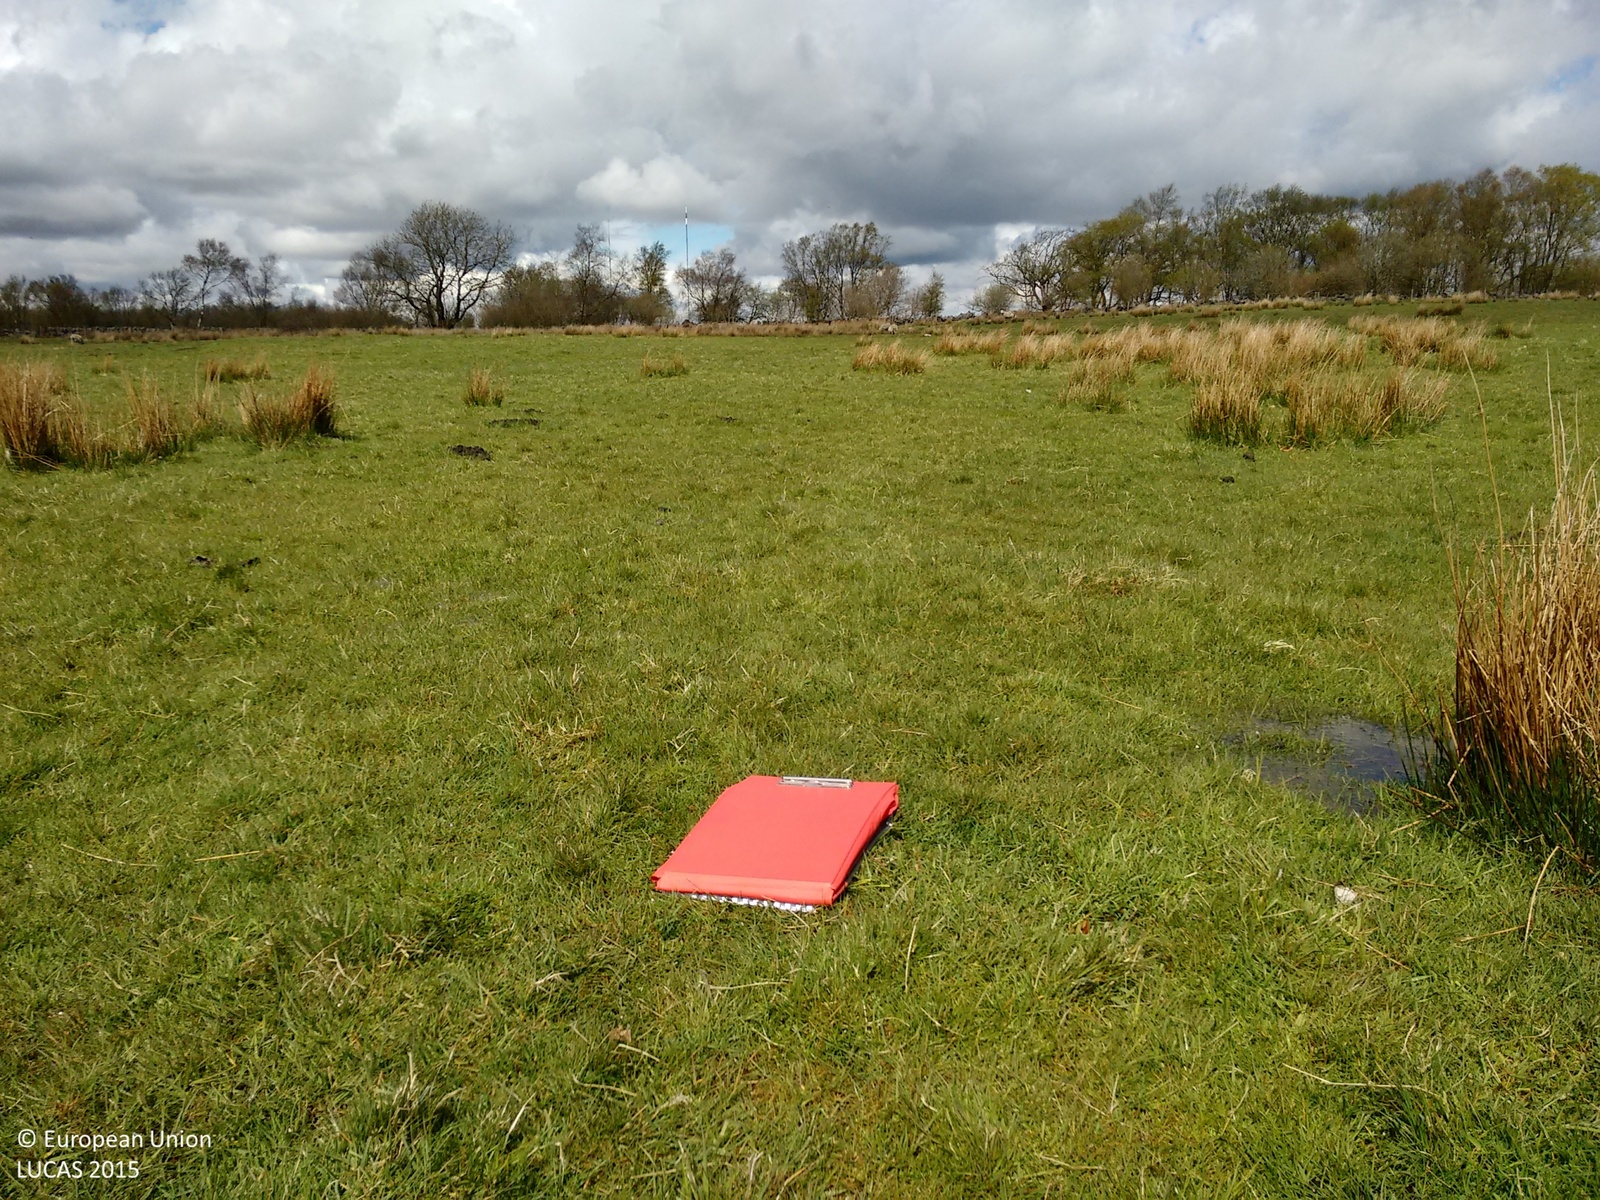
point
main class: Grassland
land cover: Grassland without tree/shrub cover
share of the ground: > 75 %
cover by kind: herbaceous plants 95 %
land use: Agriculture (excluding fallow land and kitchen gardens)
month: May
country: GB
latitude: 55.8323
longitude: -3.8634
